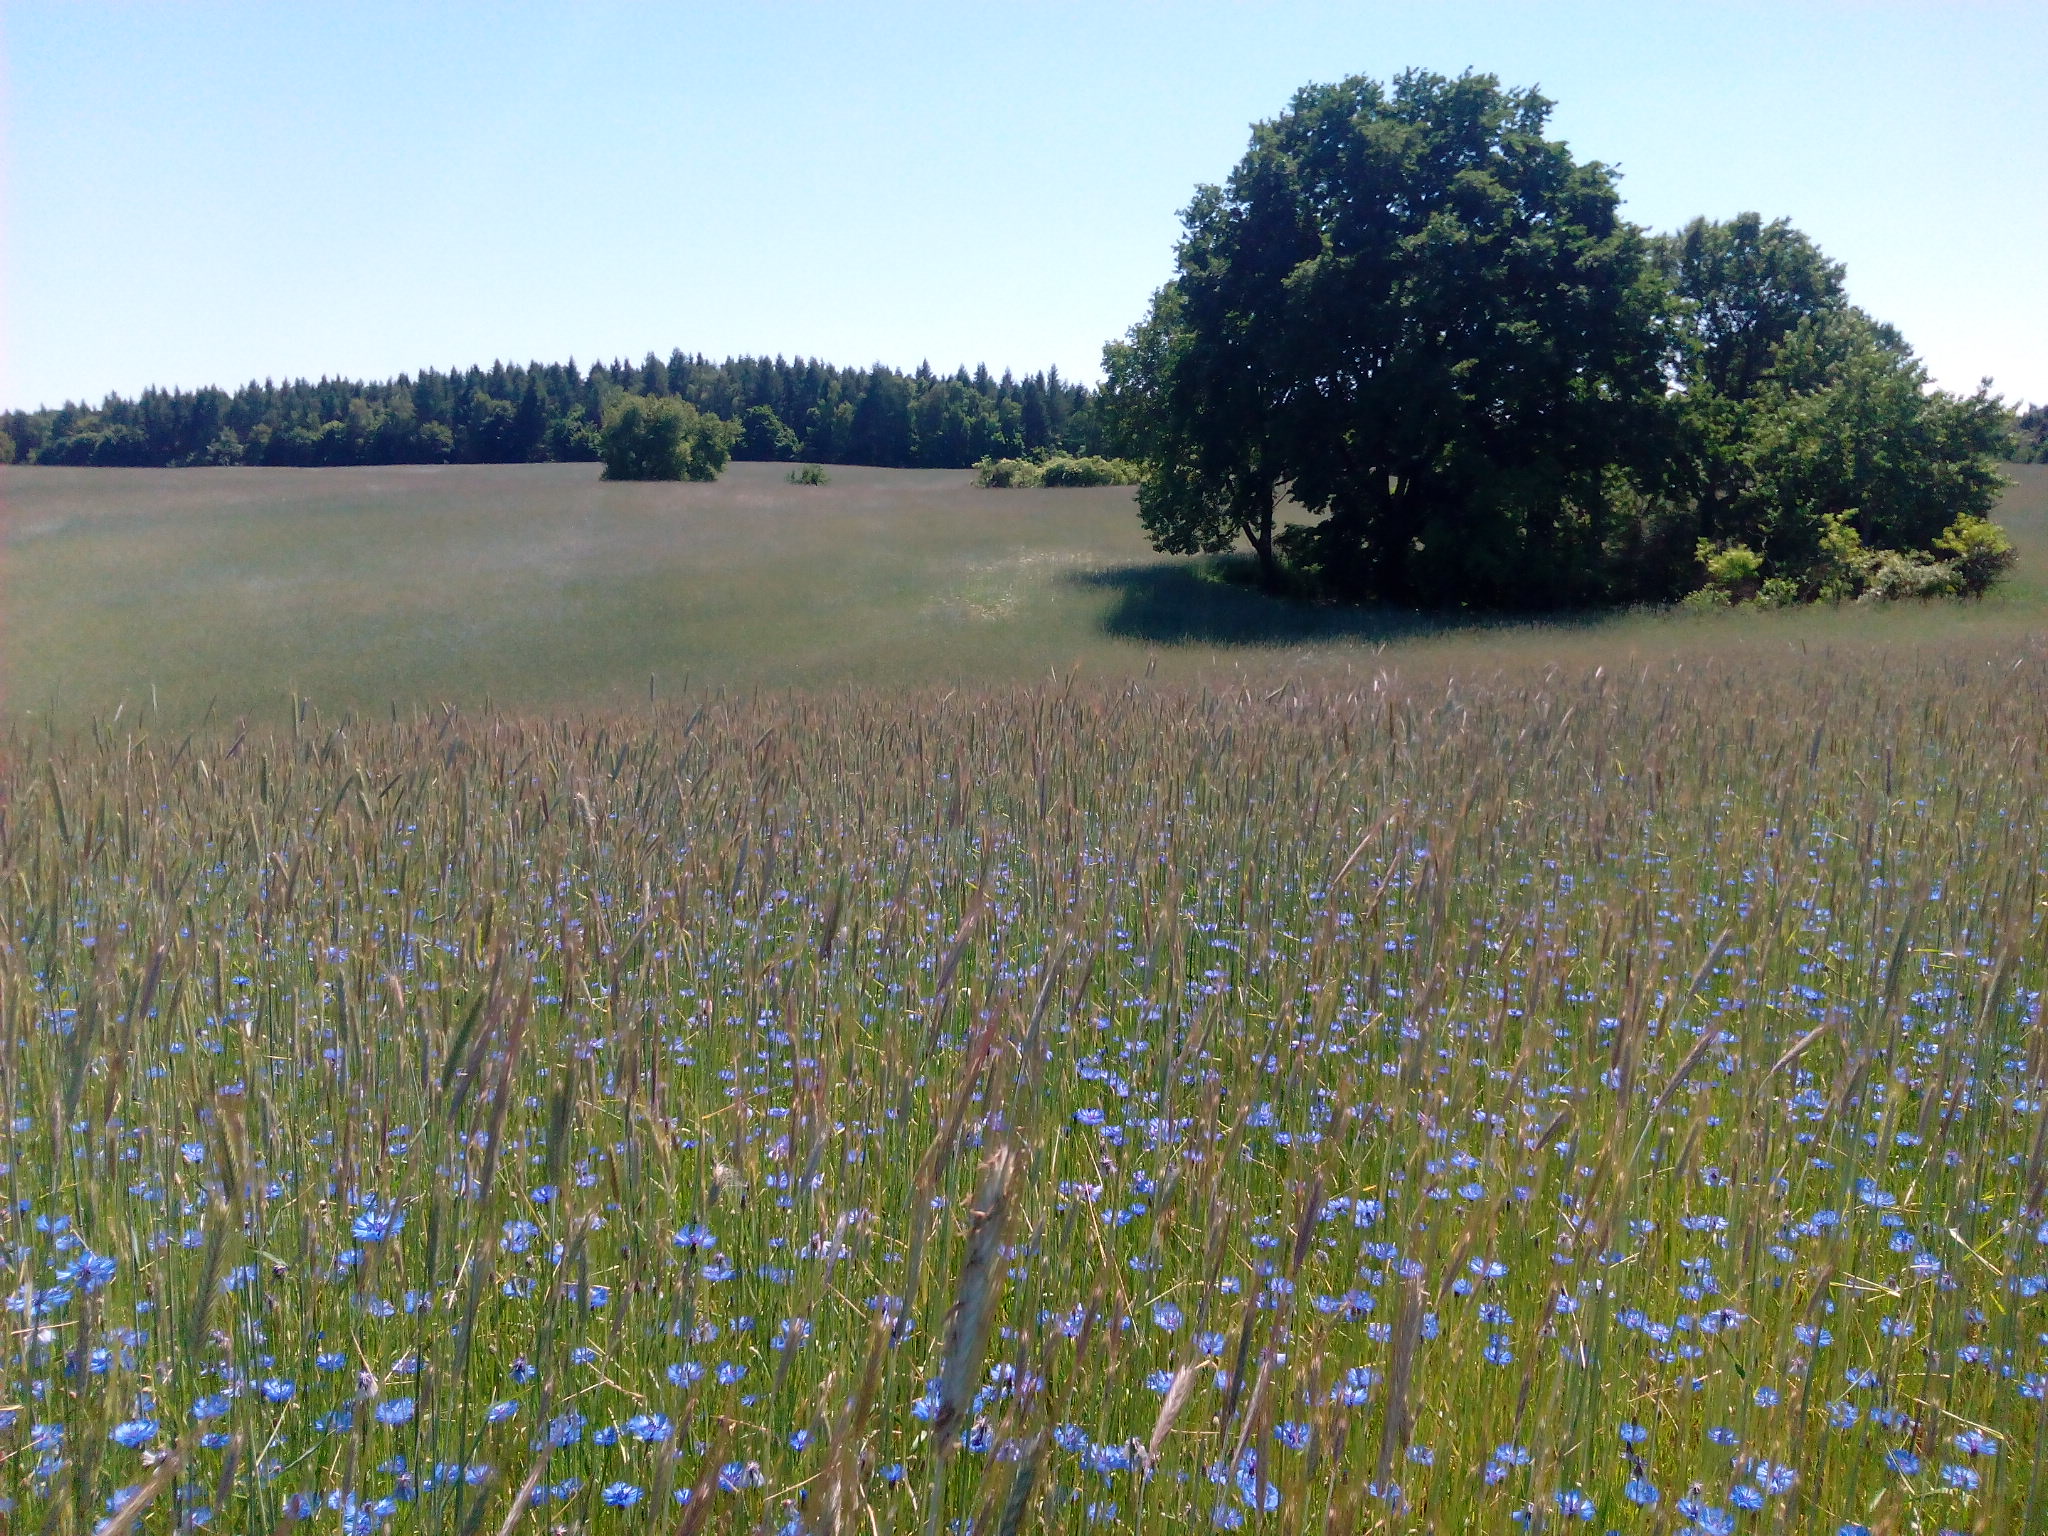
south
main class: Cropland
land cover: Mixed cereals for fodder
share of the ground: > 75 %
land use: Agriculture (excluding fallow land and kitchen gardens)
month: June
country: DE
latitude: 53.1496
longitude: 13.6335
